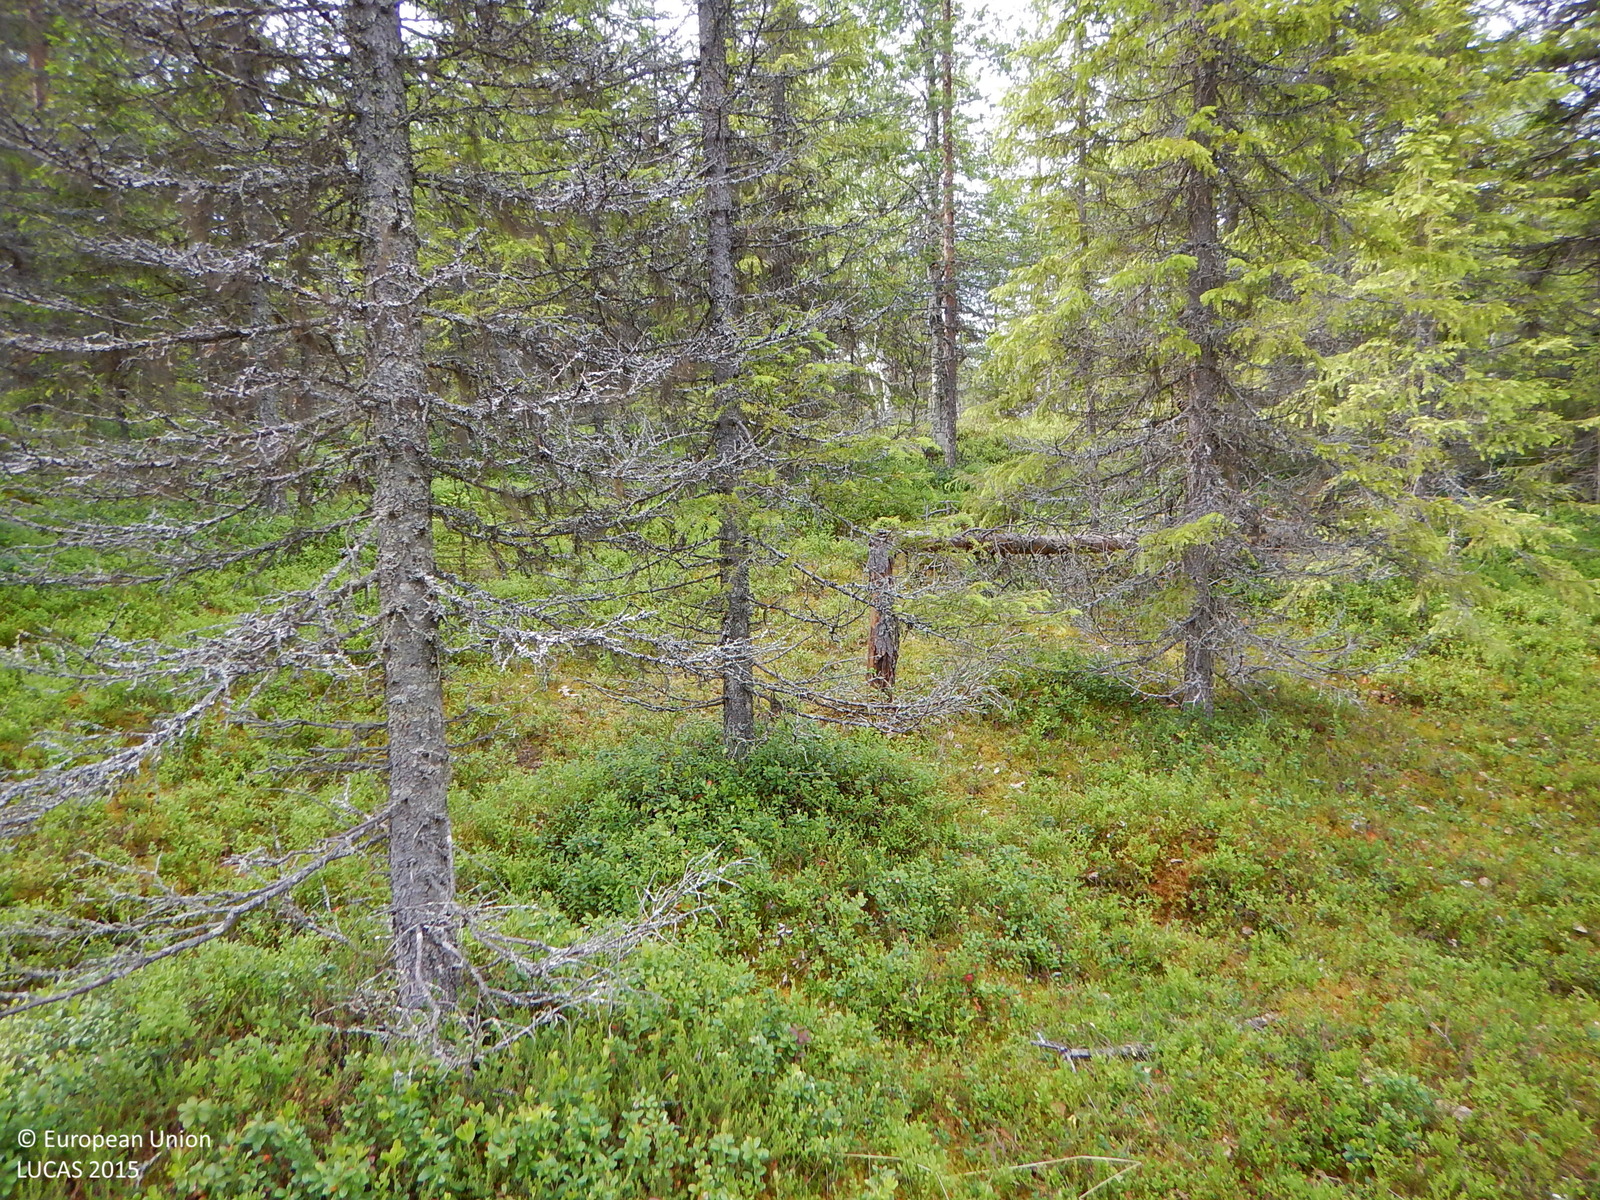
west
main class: Woodland
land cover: Spruce dominated coniferous woodland
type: boreal forest
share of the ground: 25 - 50 %
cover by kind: shrubs 40 %, coniferous forest trees 30 %, broadleaved forest trees 10 %, herbaceous plants 10 %, lichens and mosses 10 %
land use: Forestry
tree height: > 5 m
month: July
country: SE
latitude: 65.2361
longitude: 18.9708
